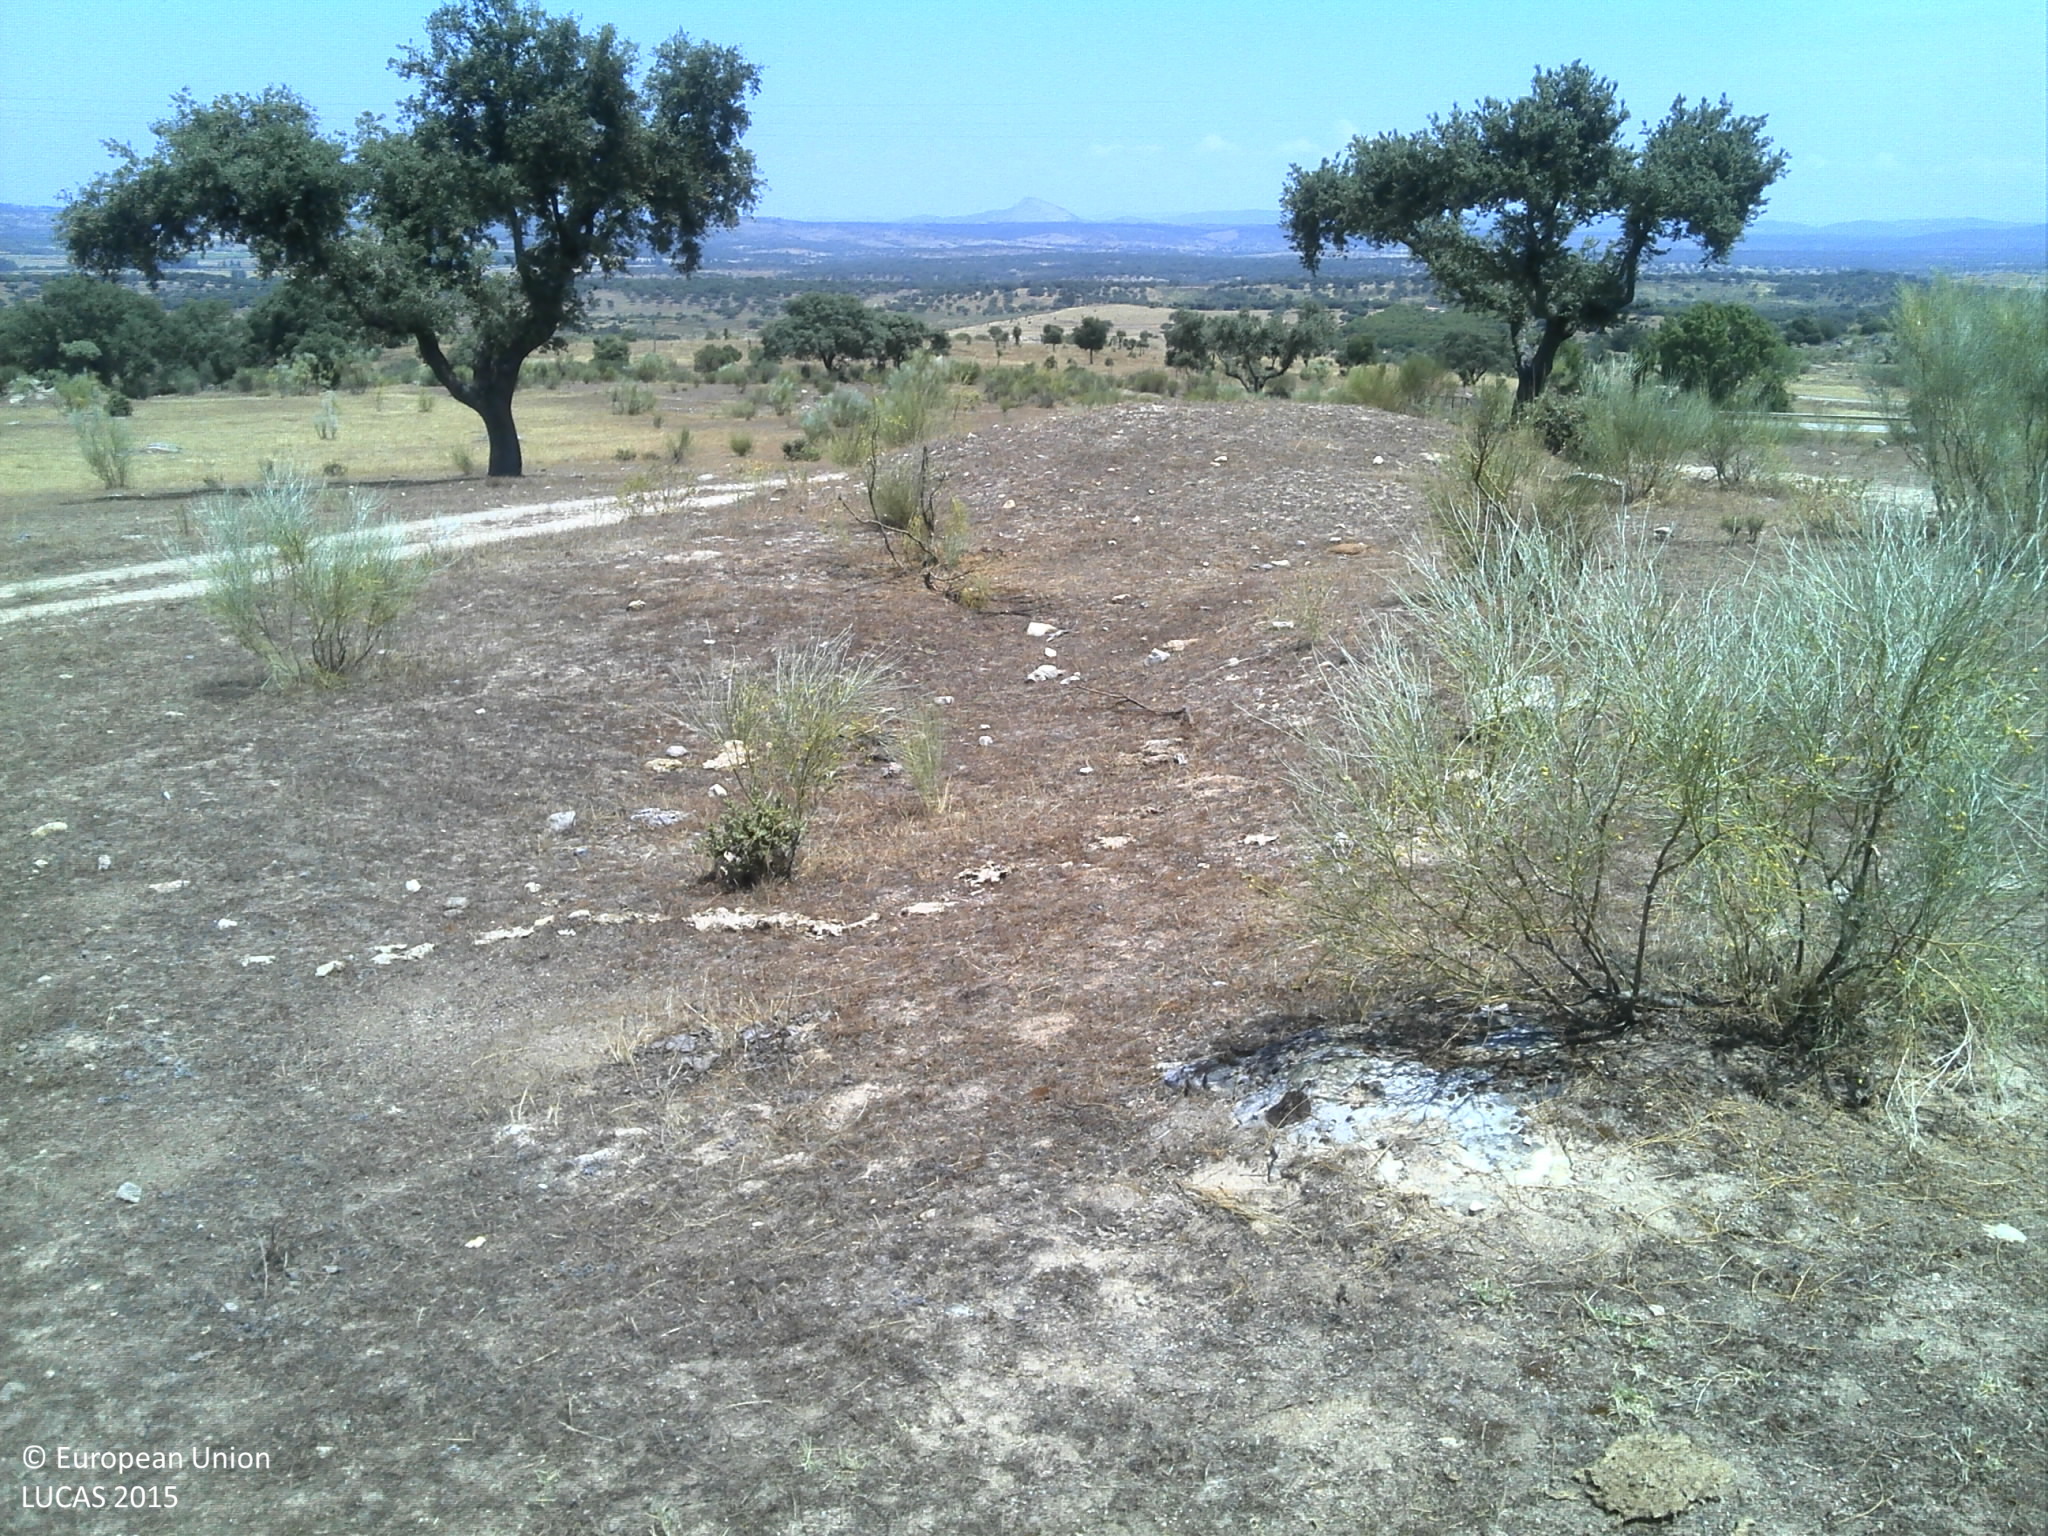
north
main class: Grassland
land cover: Grassland without tree/shrub cover
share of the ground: 10 - 25 %
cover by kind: unconsolidated bare surface 70 %, herbaceous plants 25 %
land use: Agriculture (excluding fallow land and kitchen gardens)
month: June
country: PT
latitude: 39.8387
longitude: -7.1166
